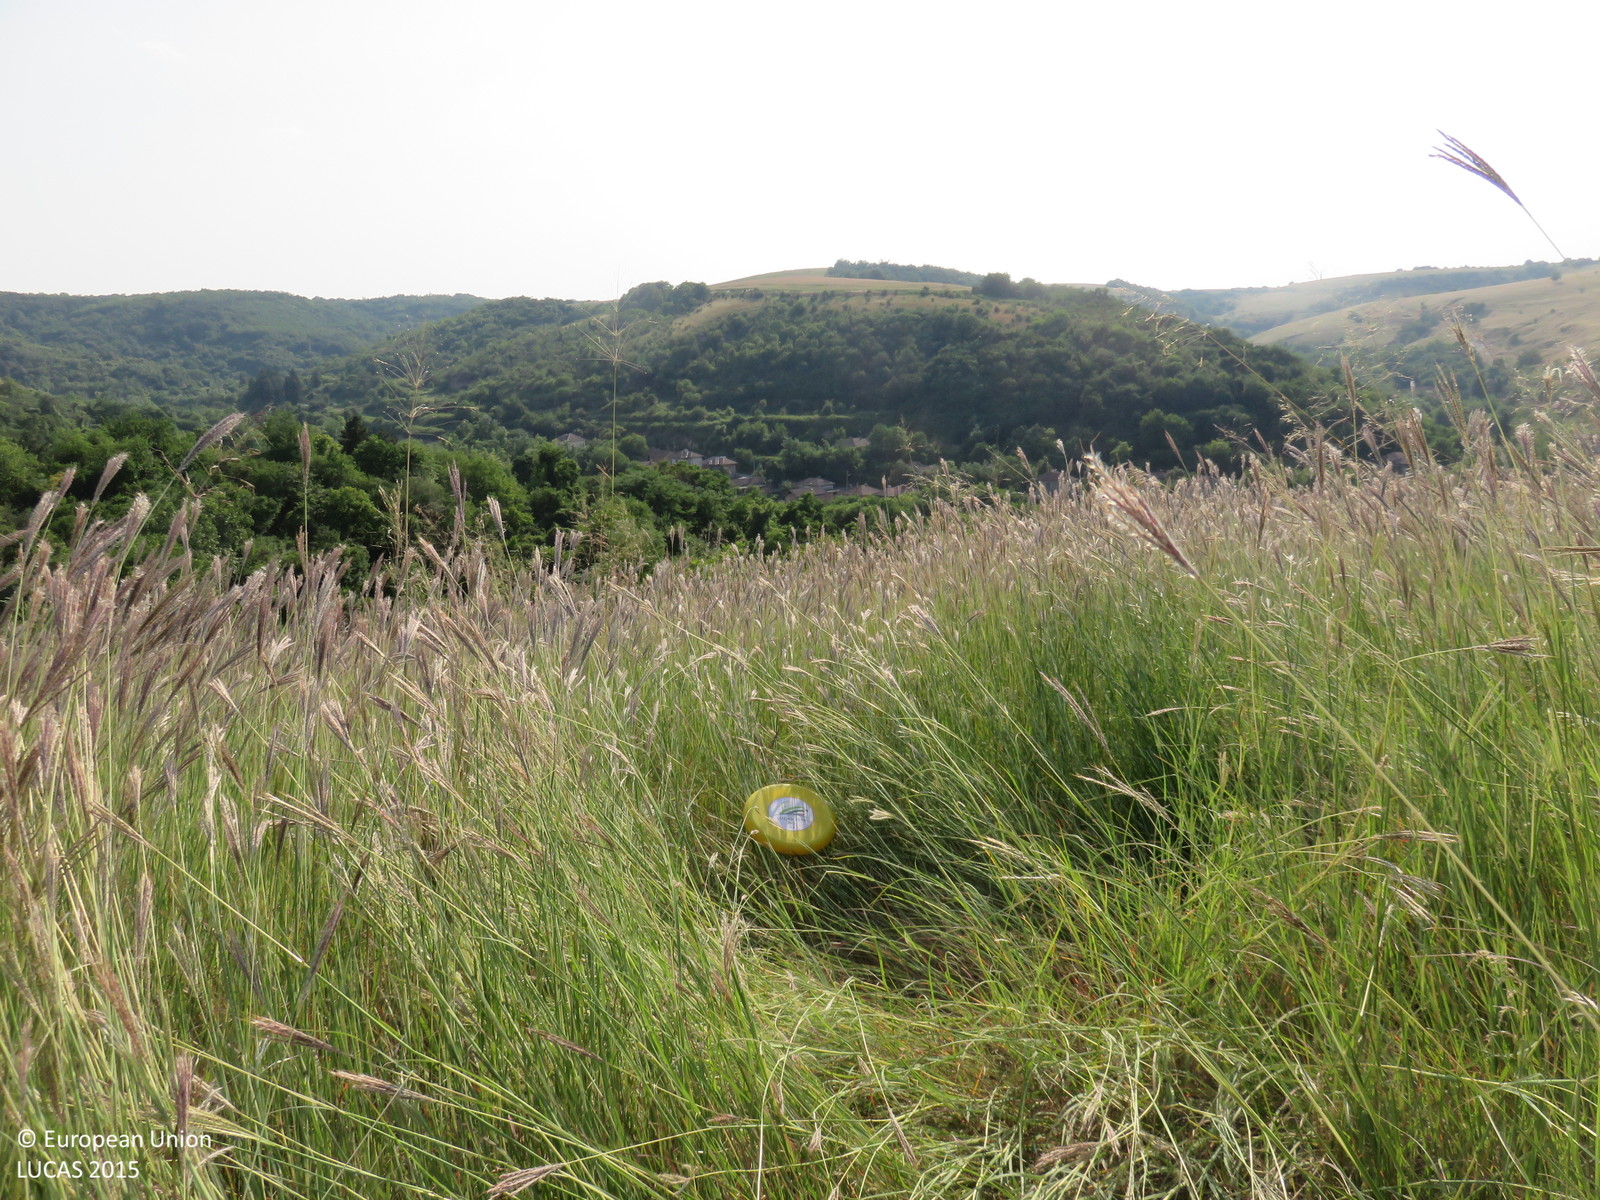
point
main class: Grassland
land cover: Grassland with sparse tree/shrub cover
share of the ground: > 75 %
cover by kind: herbaceous plants 90 %, broadleaved forest trees 5 %, shrubs 5 %
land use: Agriculture (excluding fallow land and kitchen gardens)
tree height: < 5 m
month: July
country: BG
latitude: 43.6010
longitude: 25.0000
